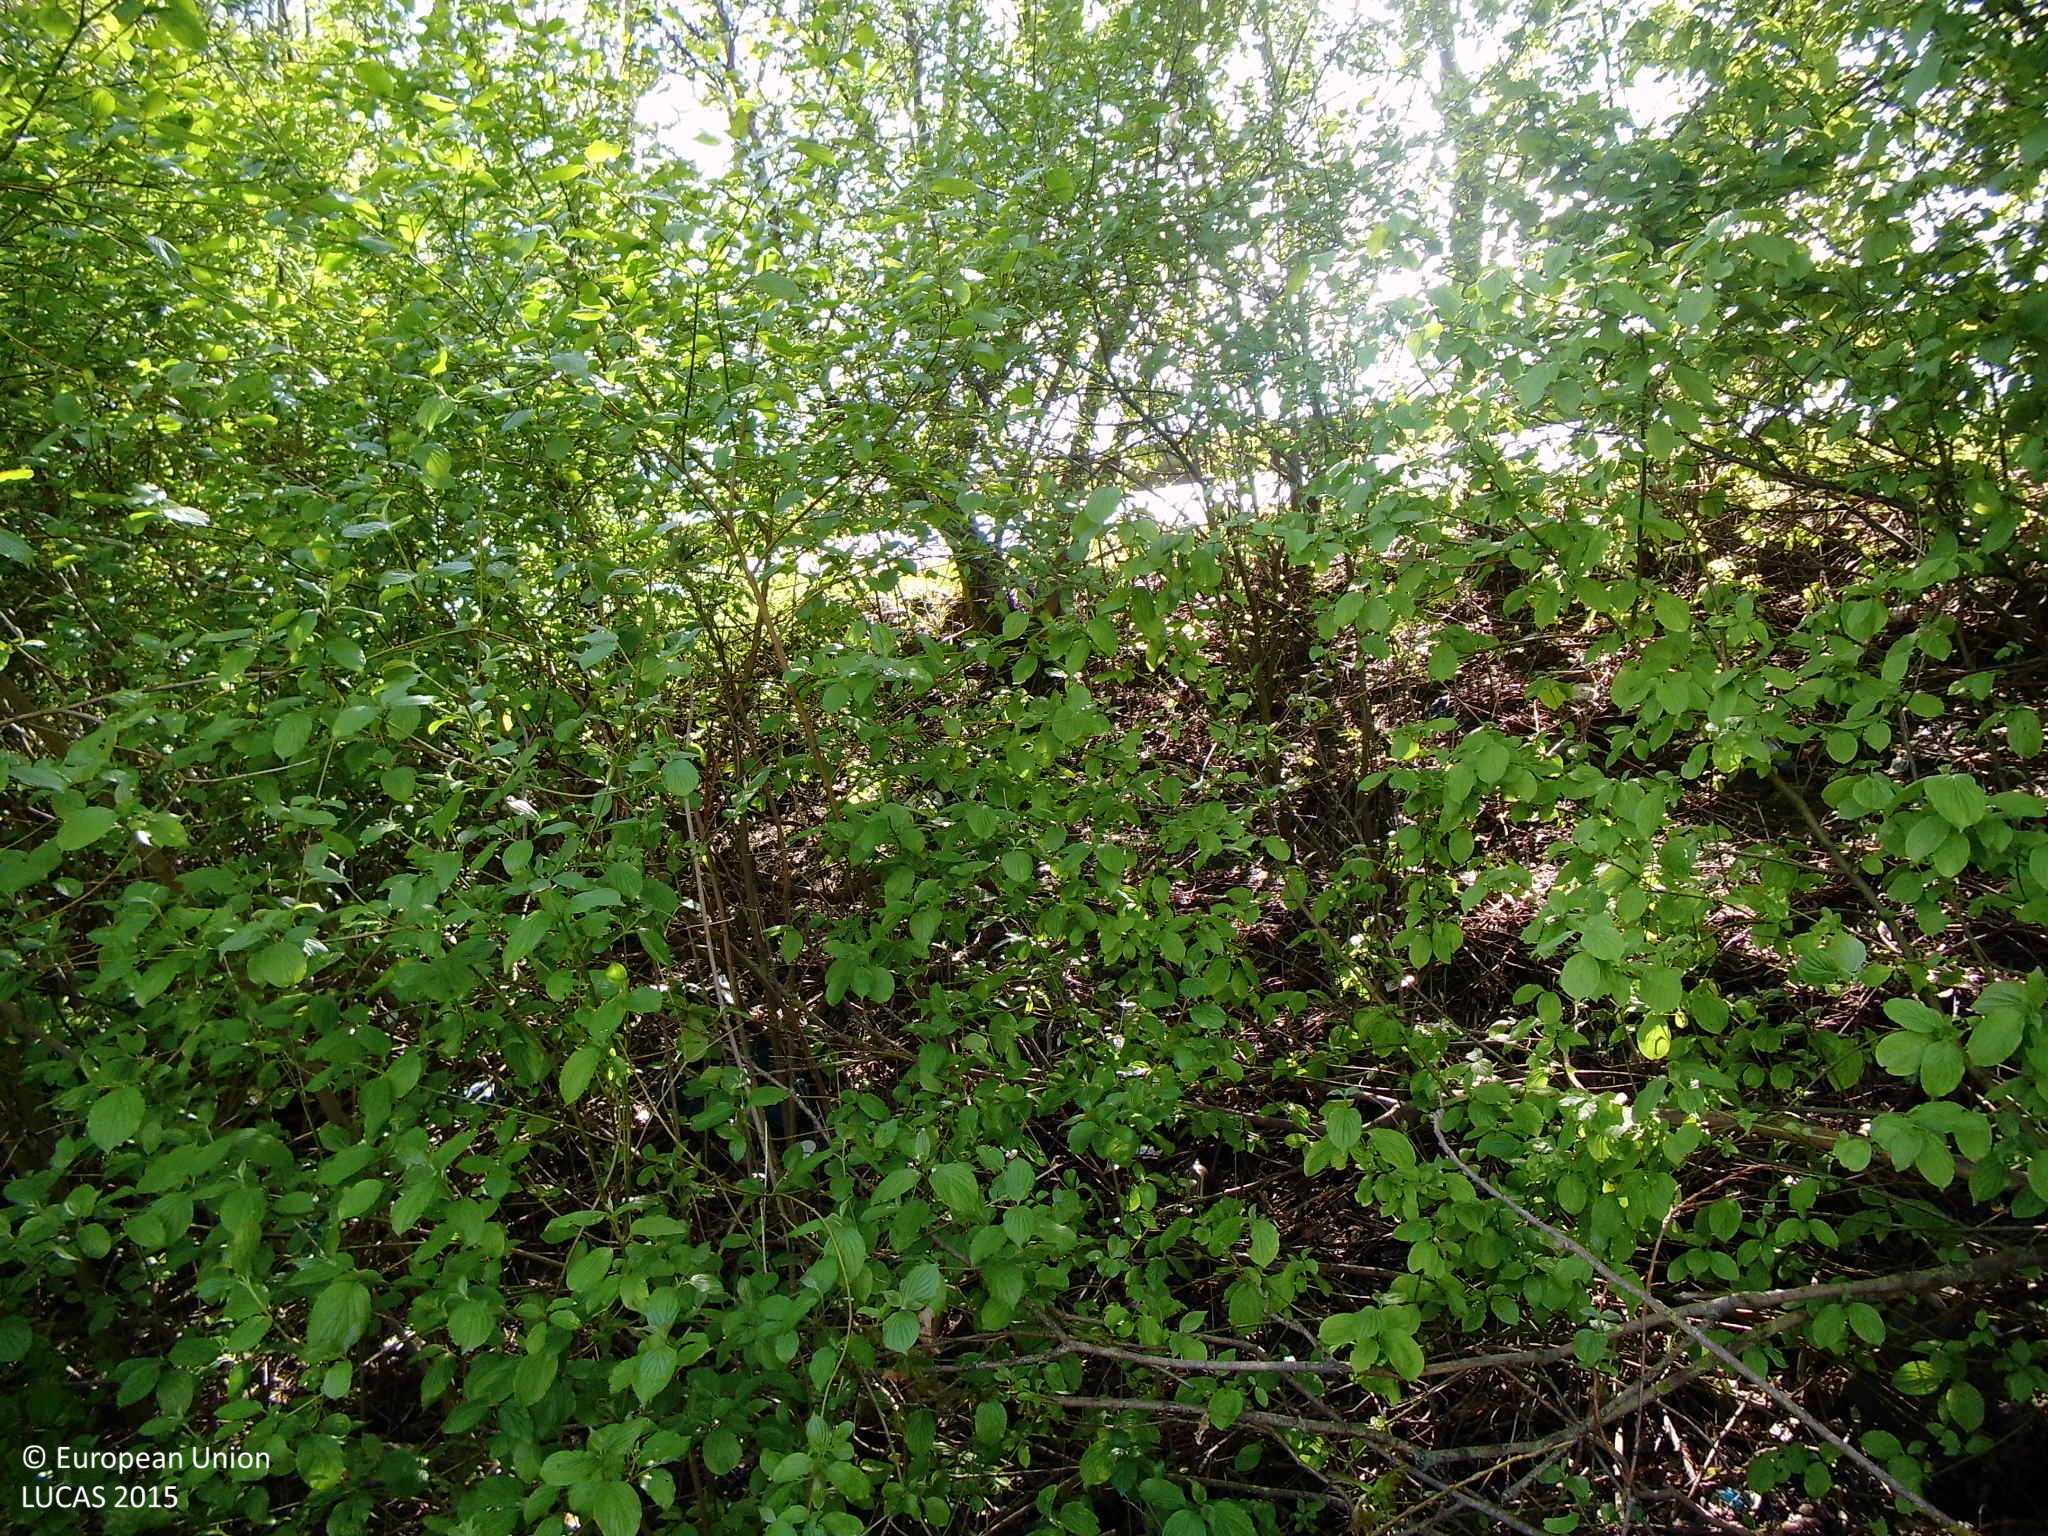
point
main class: Woodland
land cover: Broadleaved woodland
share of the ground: > 75 %
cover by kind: broadleaved forest trees 90 %, herbaceous plants 5 %, unconsolidated bare surface 5 %
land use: Road transport
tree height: > 5 m
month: May
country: DE
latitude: 51.5215
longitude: 7.3916
